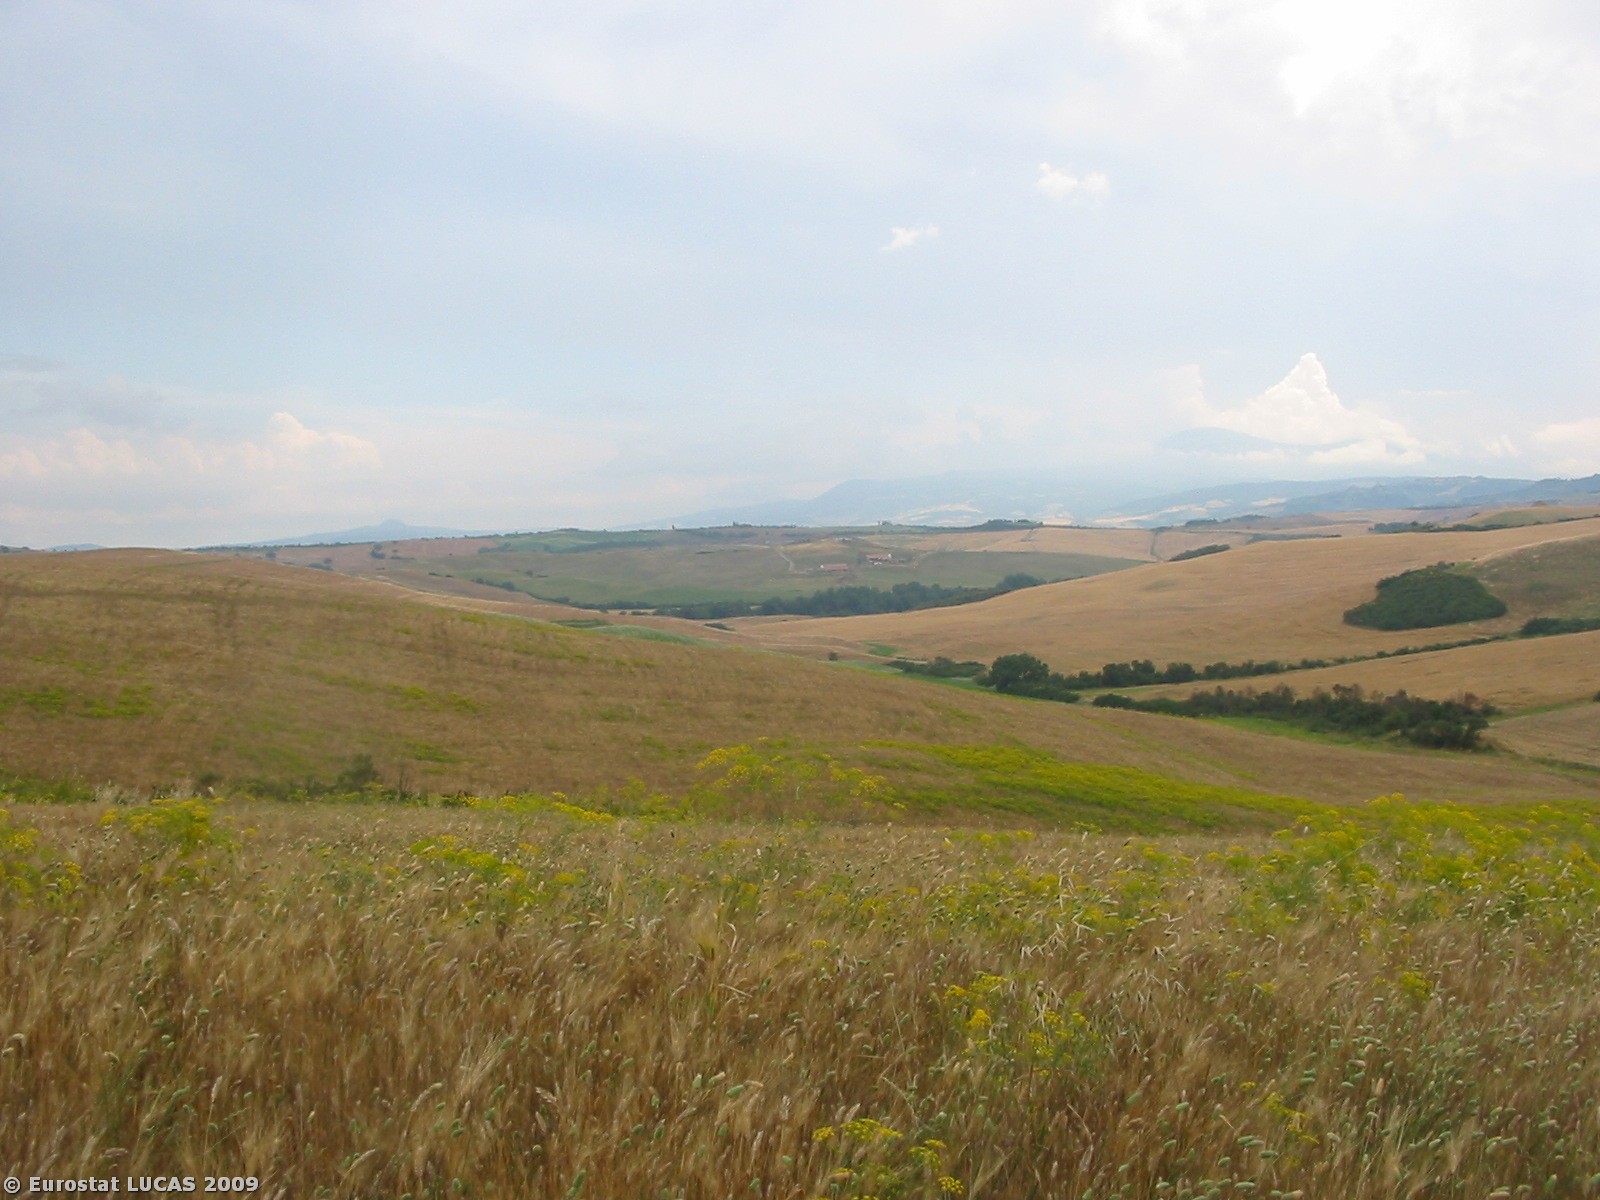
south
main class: Cropland
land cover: Durum wheat
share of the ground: > 75 %
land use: Agriculture (excluding fallow land and kitchen gardens)
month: June
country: IT
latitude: 43.1105
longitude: 11.6295
